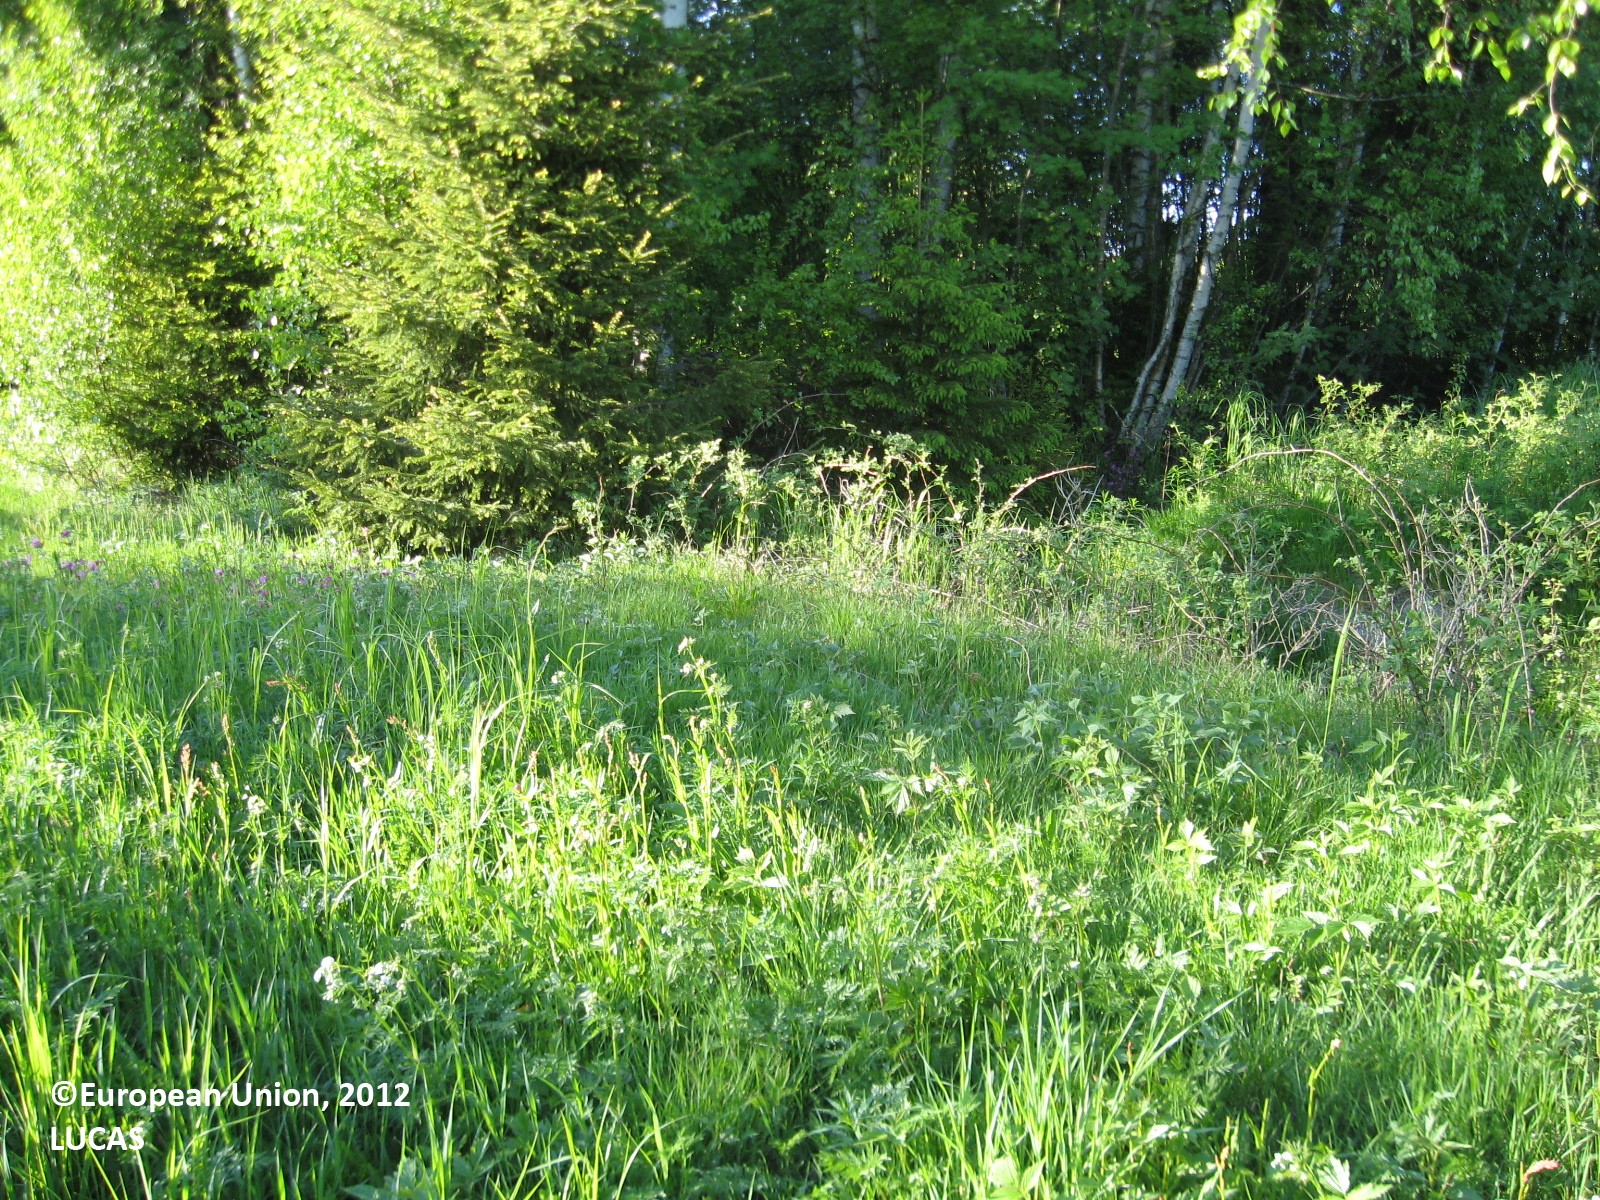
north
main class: Grassland
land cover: Grassland without tree/shrub cover
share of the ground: > 75 %
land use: Agriculture (excluding fallow land and kitchen gardens)
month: June
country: FI
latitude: 63.1422
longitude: 21.6866
